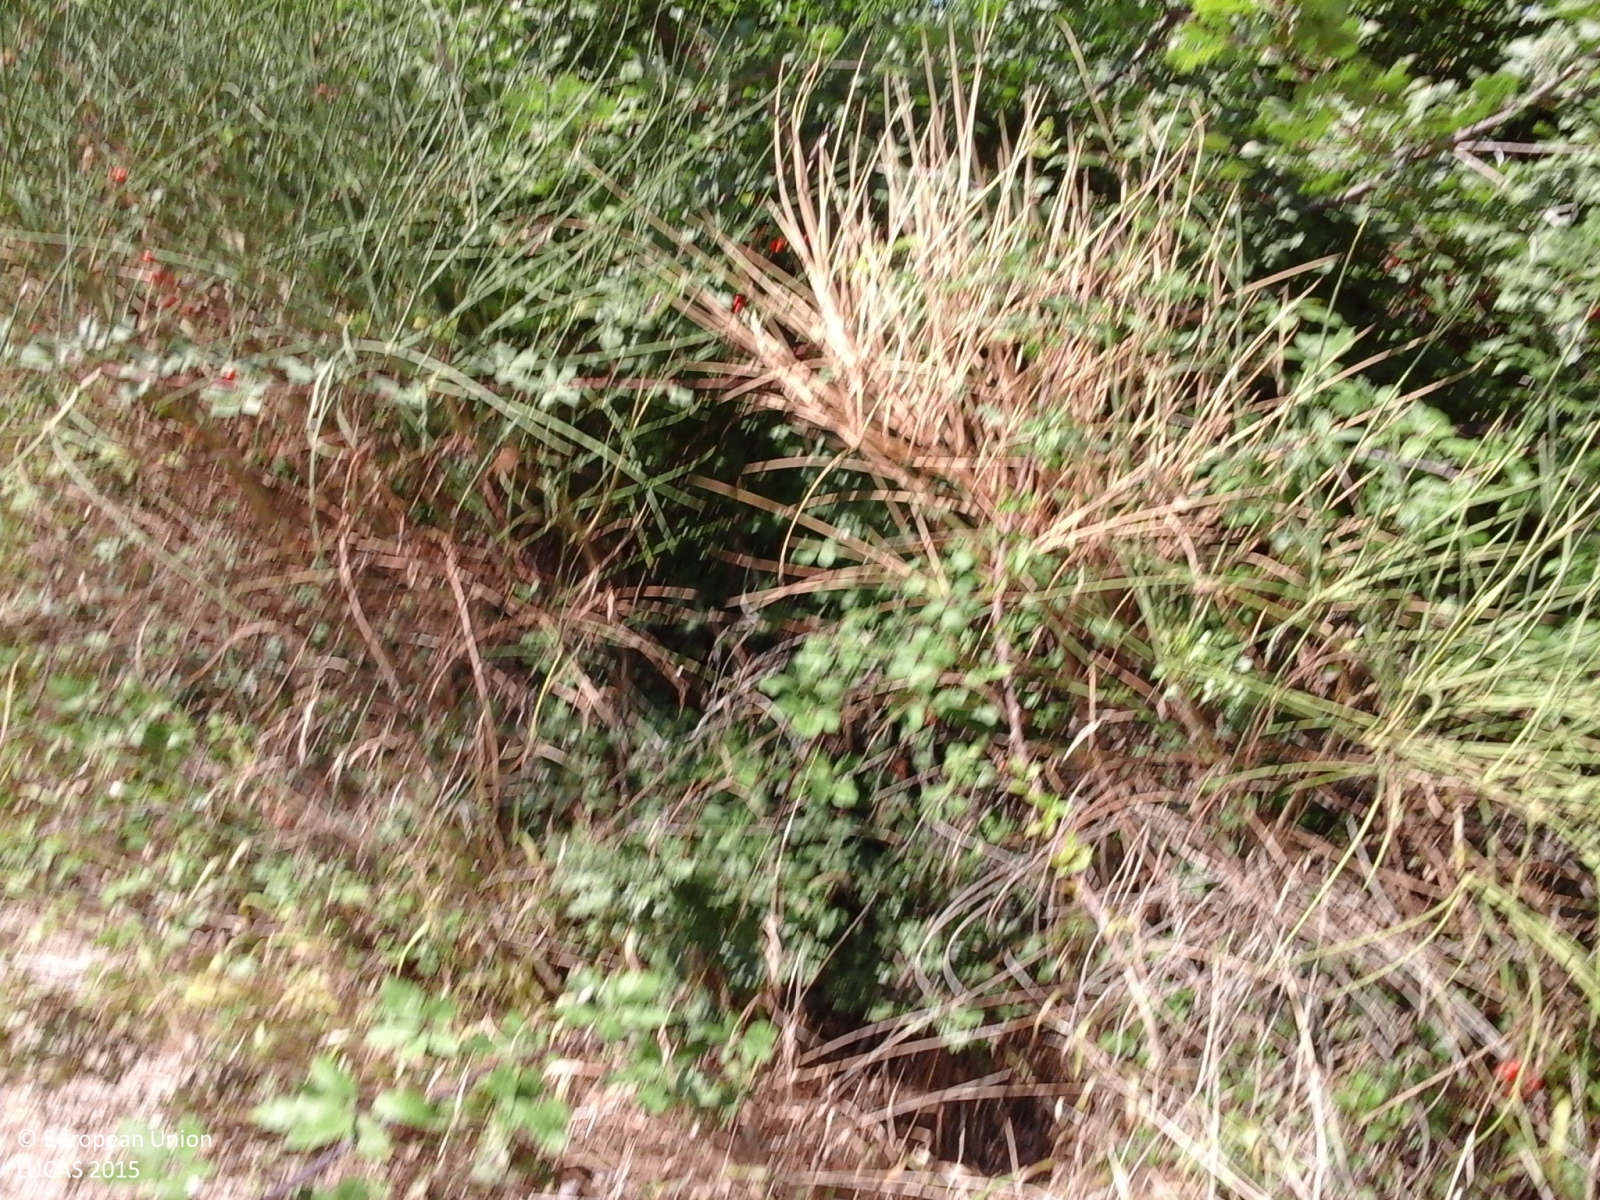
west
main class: Woodland
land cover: Broadleaved woodland
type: thermophilous deciduous forest
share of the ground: > 75 %
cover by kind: broadleaved forest trees 95 %, shrubs 5 %
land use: Forestry
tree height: > 5 m
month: August
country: IT
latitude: 41.8910
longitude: 12.8459
